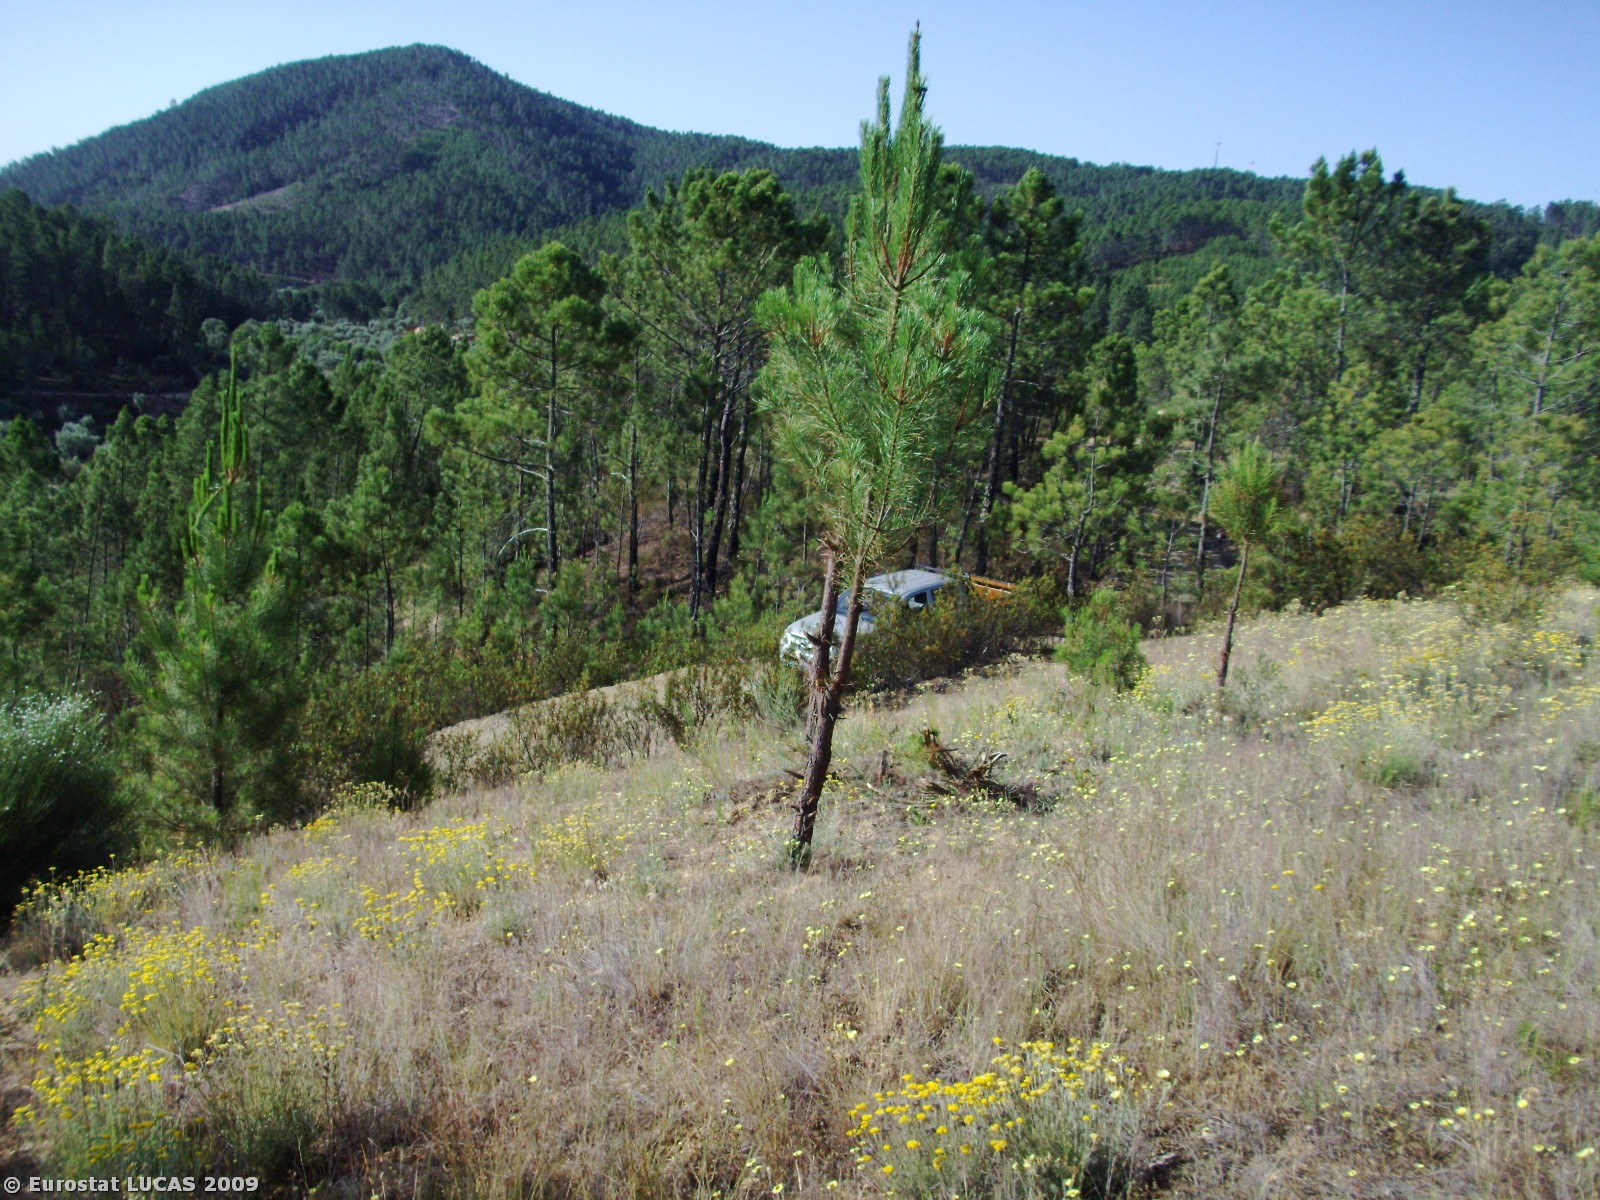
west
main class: Woodland
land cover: Coniferous woodland
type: coniferous forest of the mediterranean region
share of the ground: 25 - 50 %
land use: Forestry
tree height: > 5 m
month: June
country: PT
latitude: 39.9806
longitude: -7.6592
